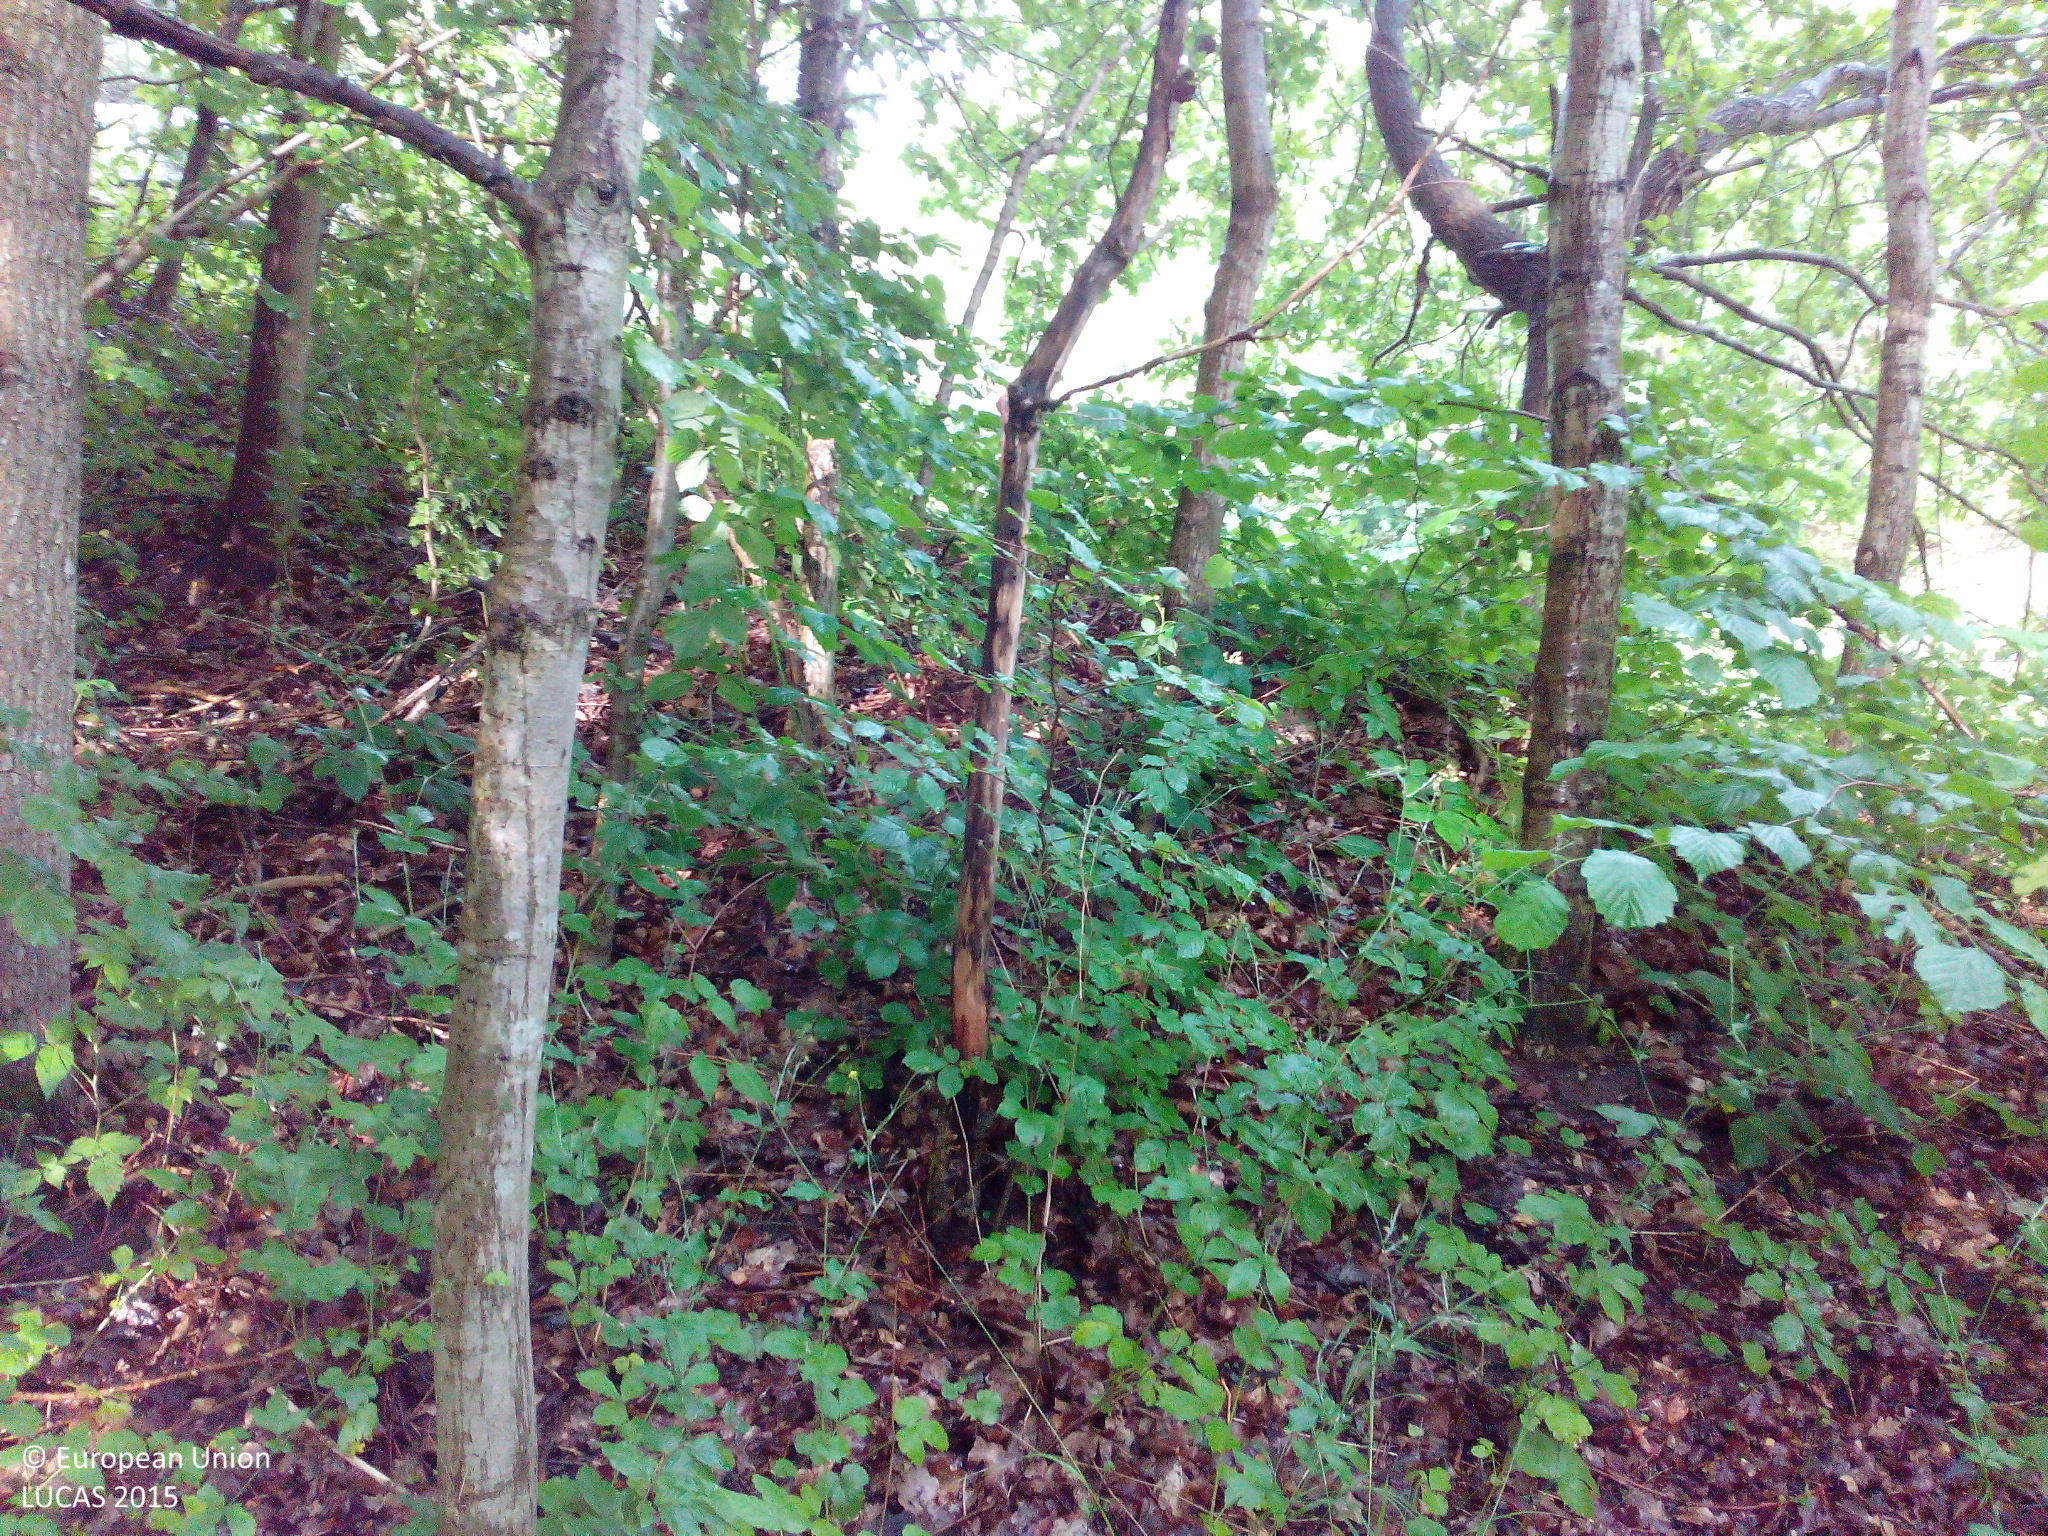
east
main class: Woodland
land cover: Broadleaved woodland
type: acidophilous oak and oak-birch forest
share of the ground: > 75 %
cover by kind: broadleaved forest trees 100 %
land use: Forestry
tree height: > 5 m
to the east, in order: Broadleaved woodland; Spontaneously vegetated surfaces; Paved roads, cycling and walking lanes; Grass margins; Broadleaved woodland; Inland marshes; Broadleaved woodland; Tracks
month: July
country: DK
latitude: 55.9151
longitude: 12.3178
